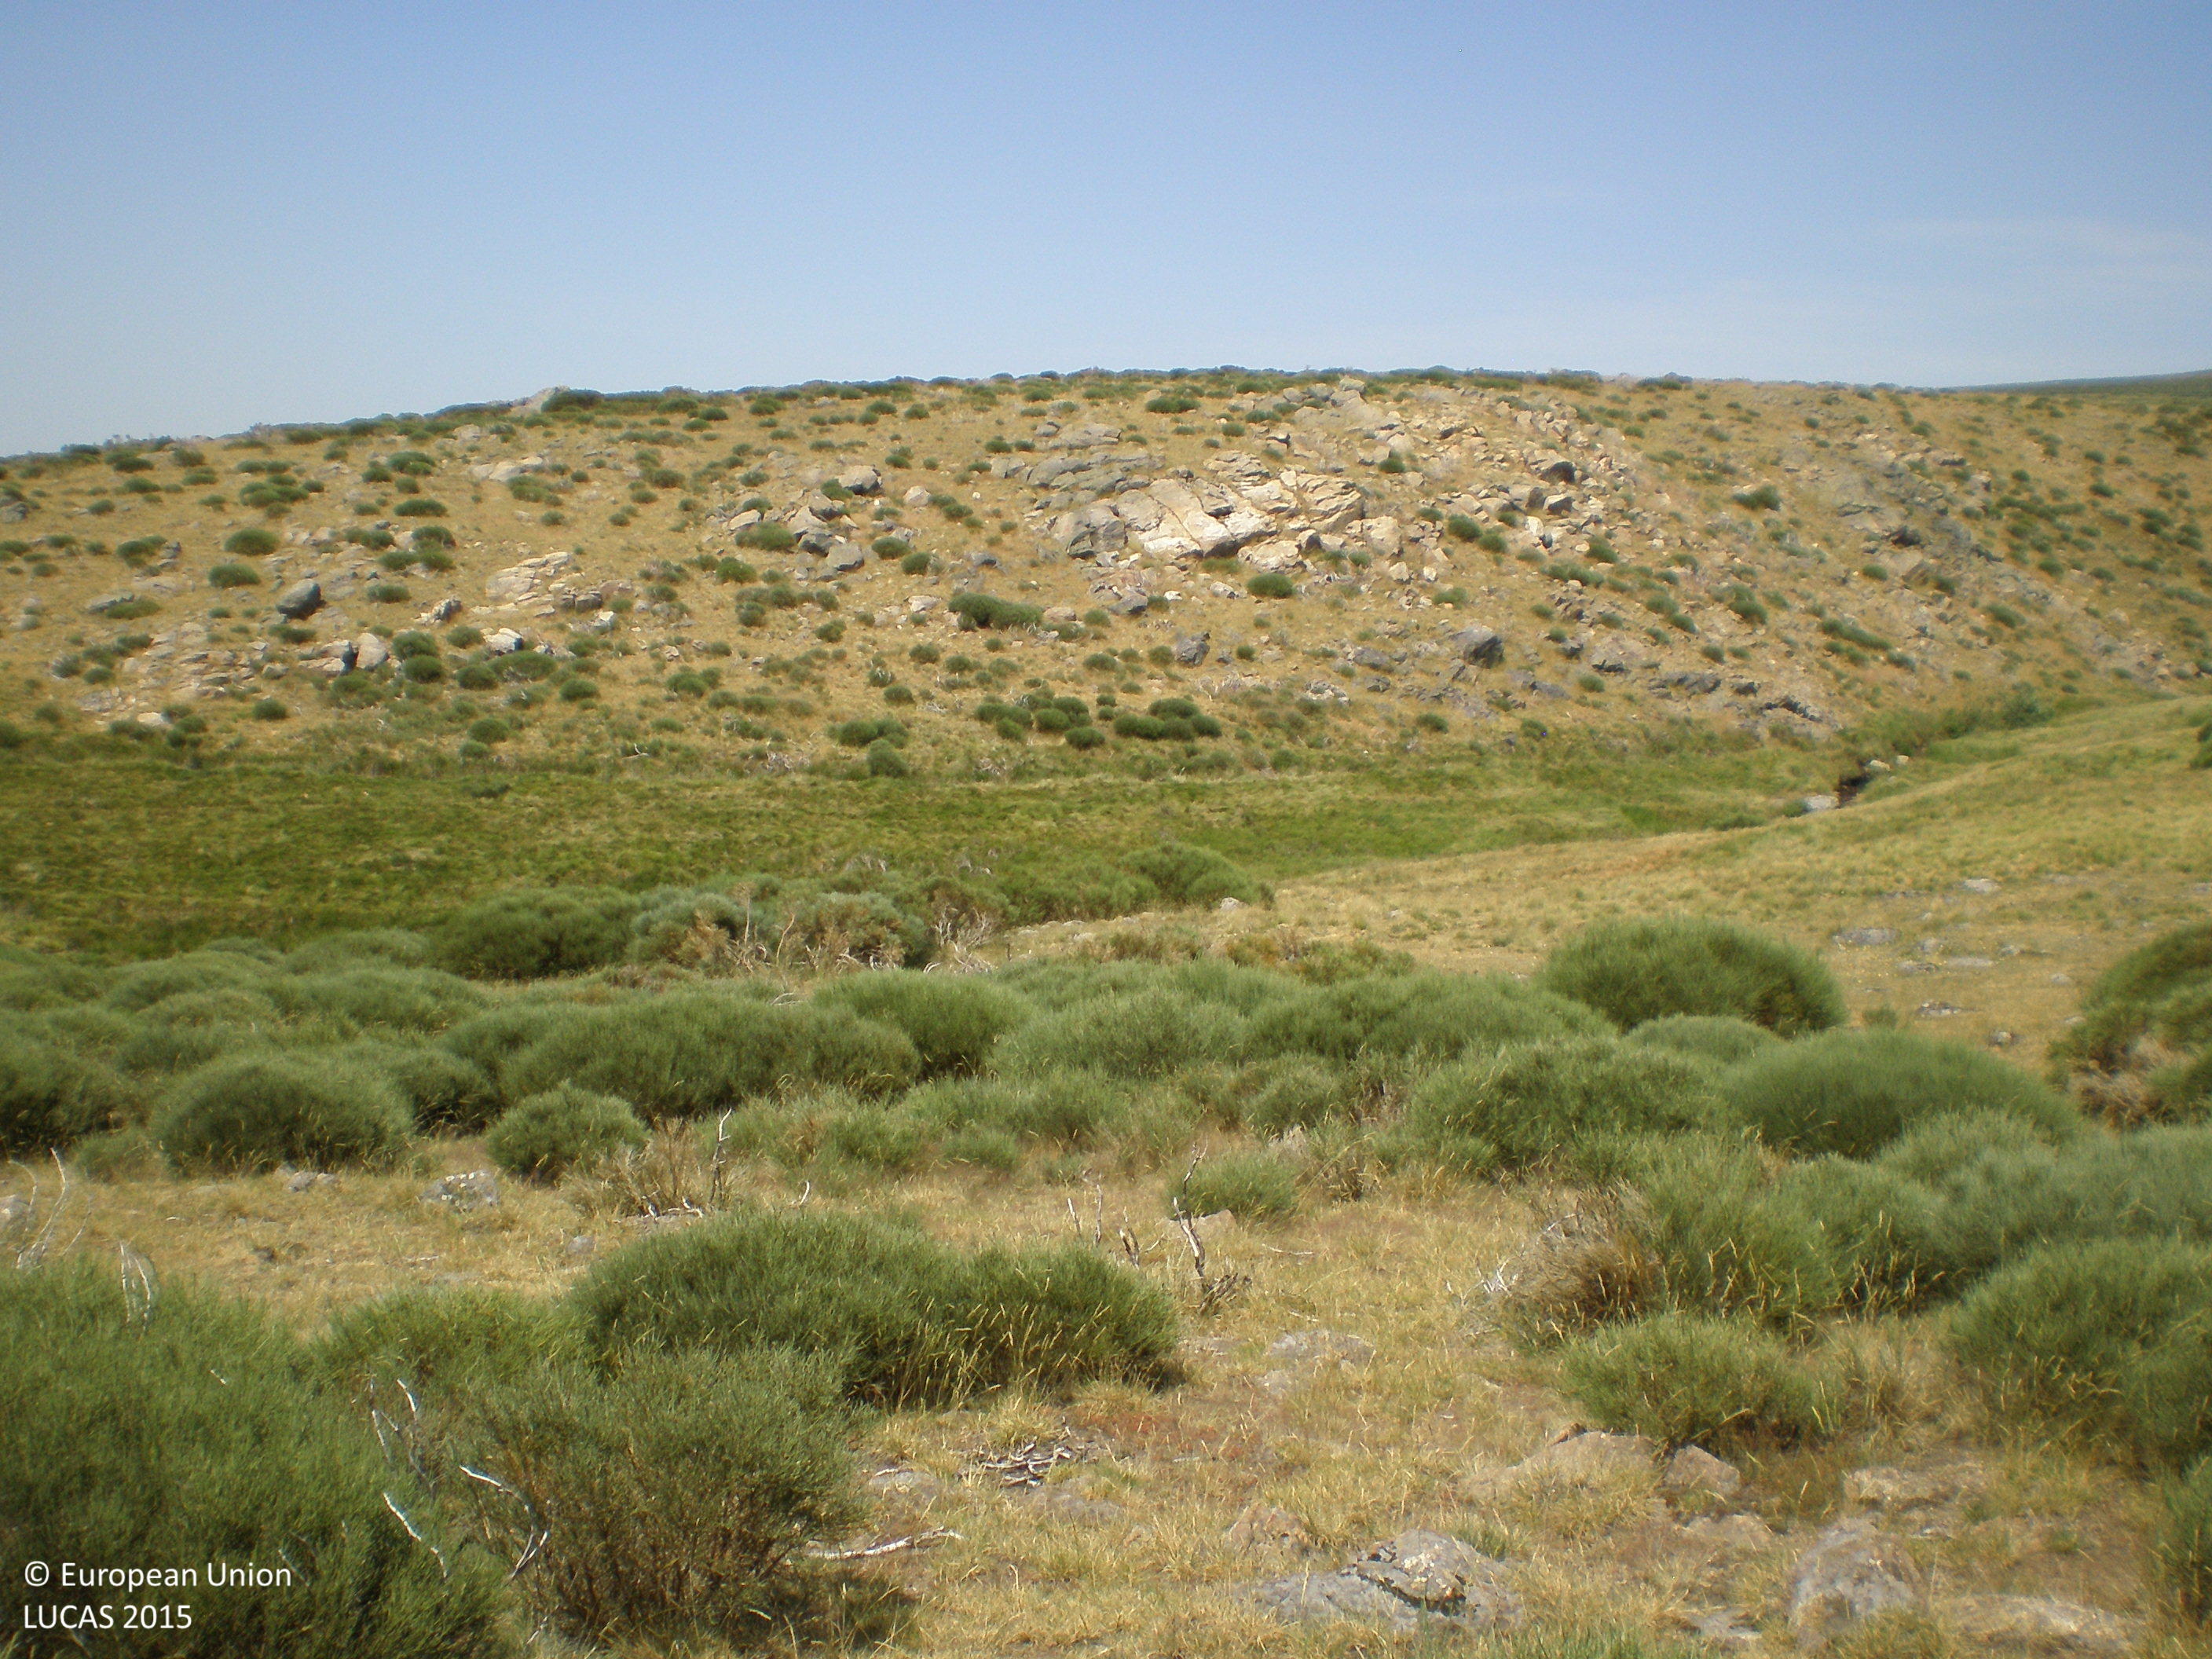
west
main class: Shrubland
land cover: Shrubland without tree cover
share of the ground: > 75 %
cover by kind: shrubs 80 %, herbaceous plants 20 %
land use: Agriculture (excluding fallow land and kitchen gardens)
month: July
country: ES
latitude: 40.4296
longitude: -5.2319
